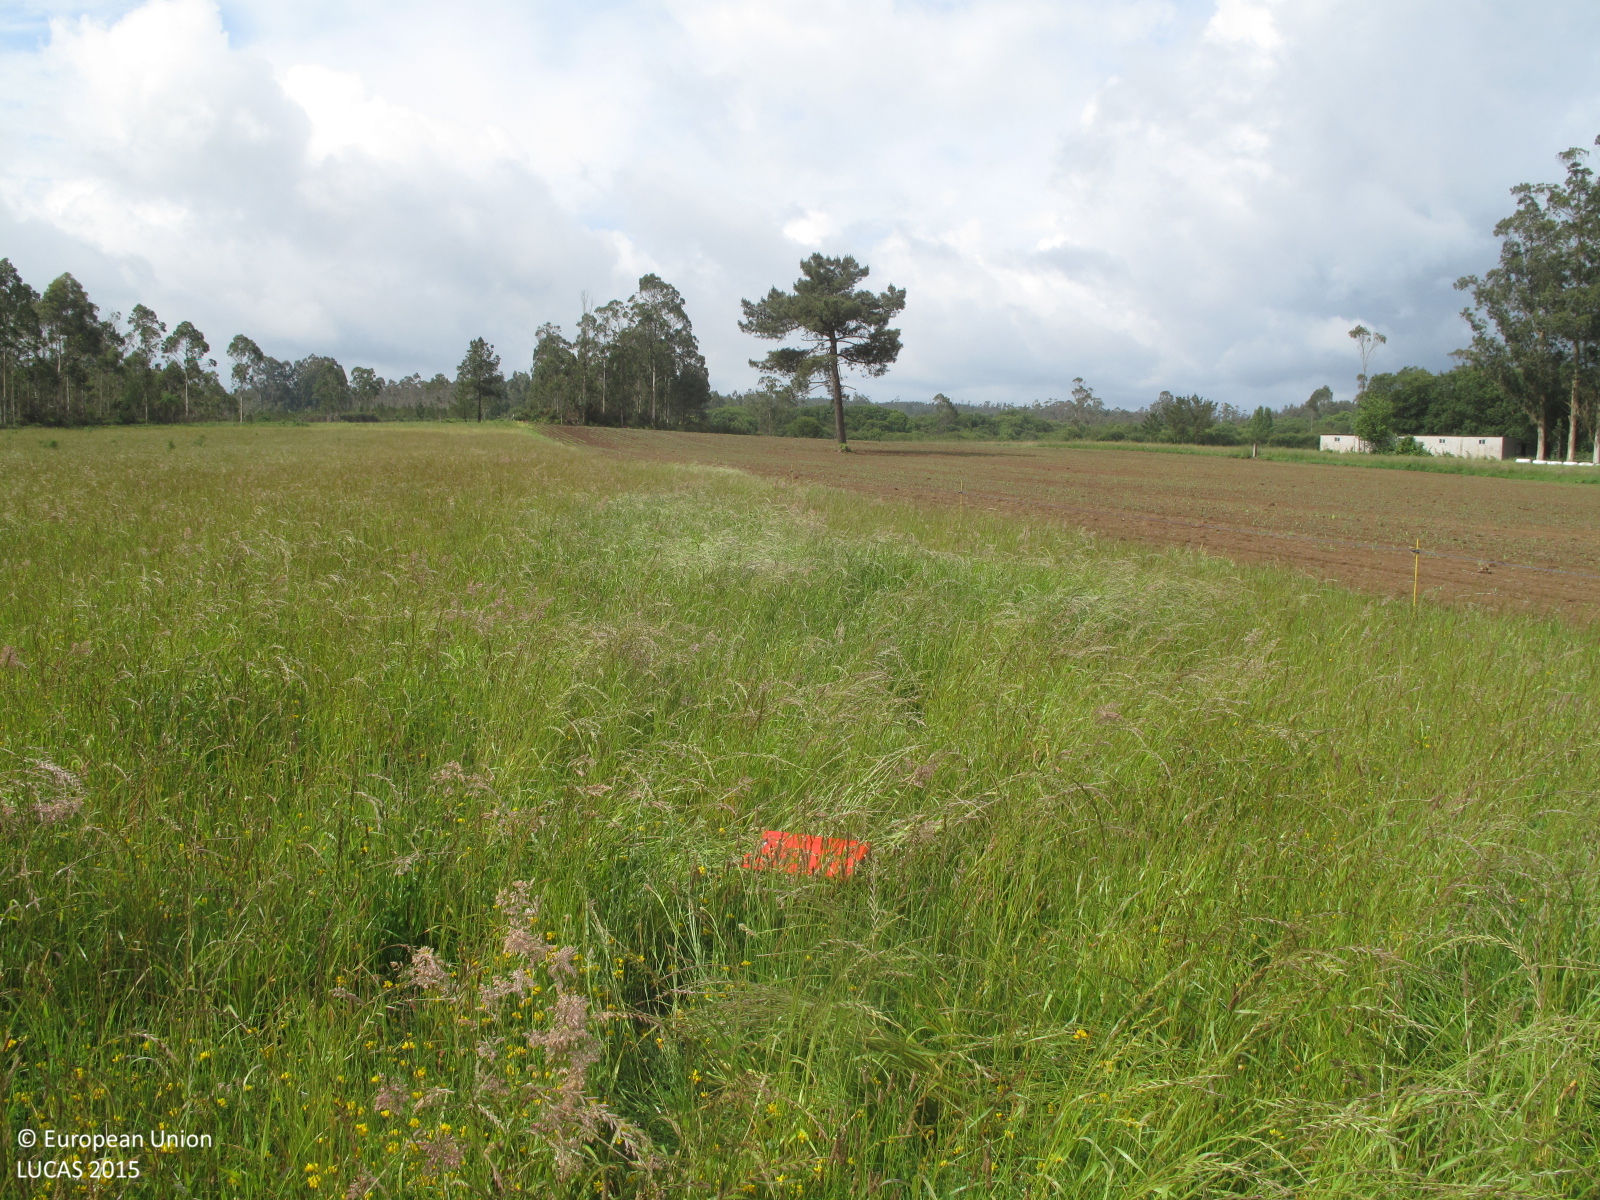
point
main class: Grassland
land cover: Grassland without tree/shrub cover
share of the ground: > 75 %
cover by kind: herbaceous plants 100 %
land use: Agriculture (excluding fallow land and kitchen gardens)
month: June
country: ES
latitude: 43.1289
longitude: -8.6104
